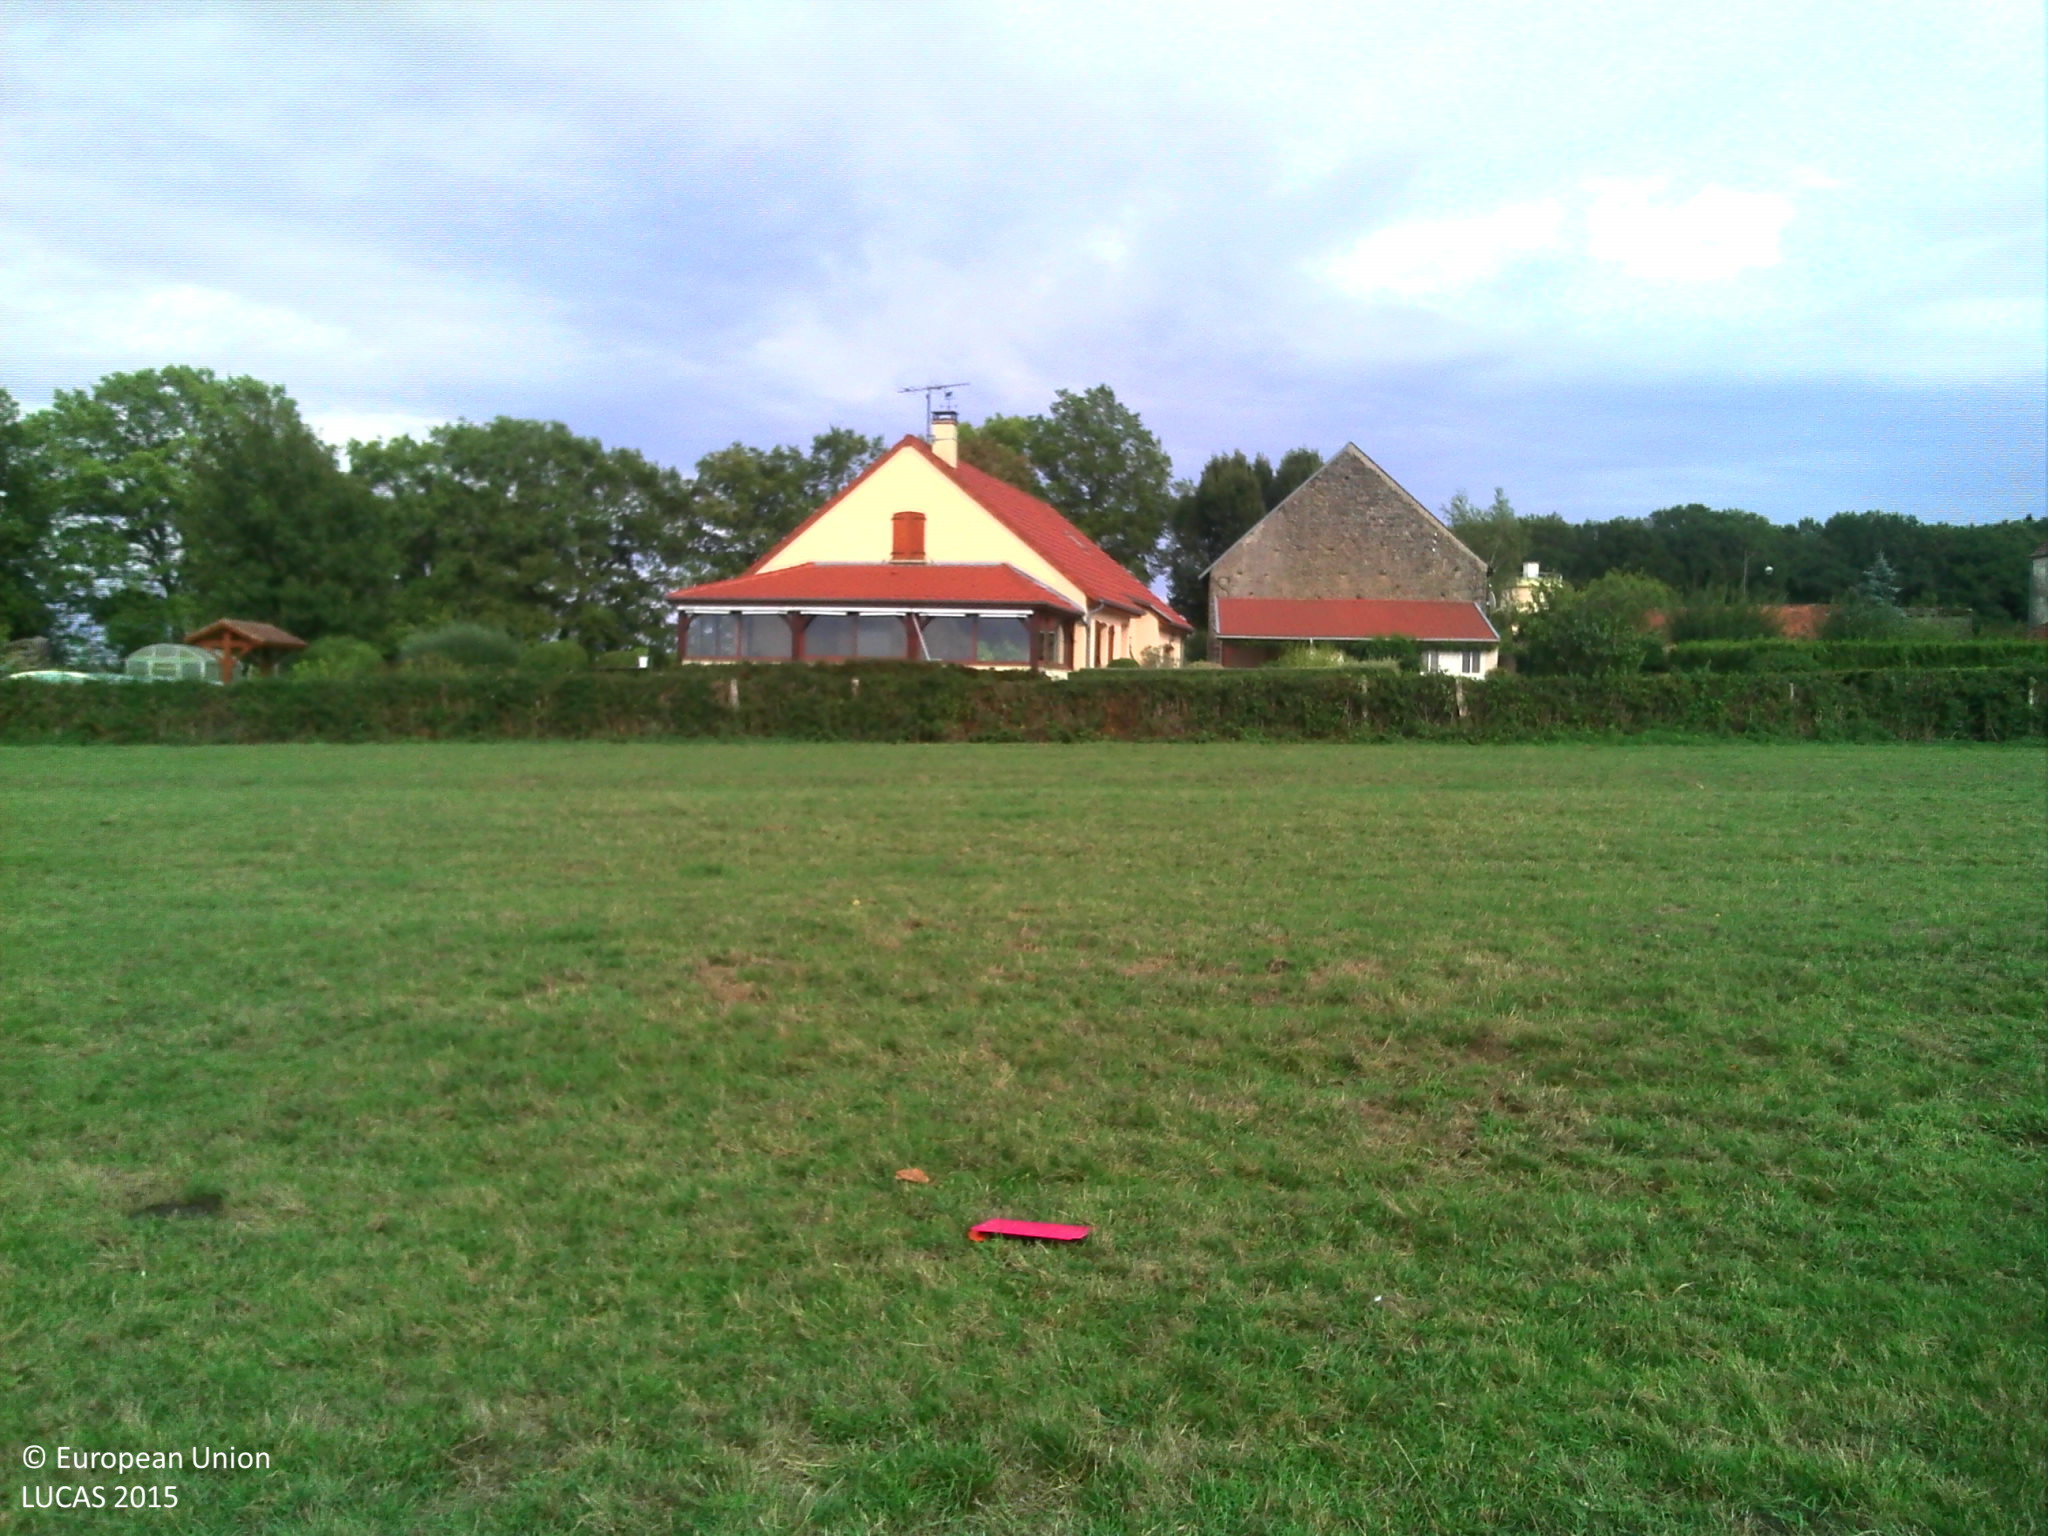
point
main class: Grassland
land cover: Grassland without tree/shrub cover
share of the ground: > 75 %
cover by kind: herbaceous plants 100 %
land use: Agriculture (excluding fallow land and kitchen gardens)
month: September
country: FR
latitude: 47.3913
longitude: 4.3155
